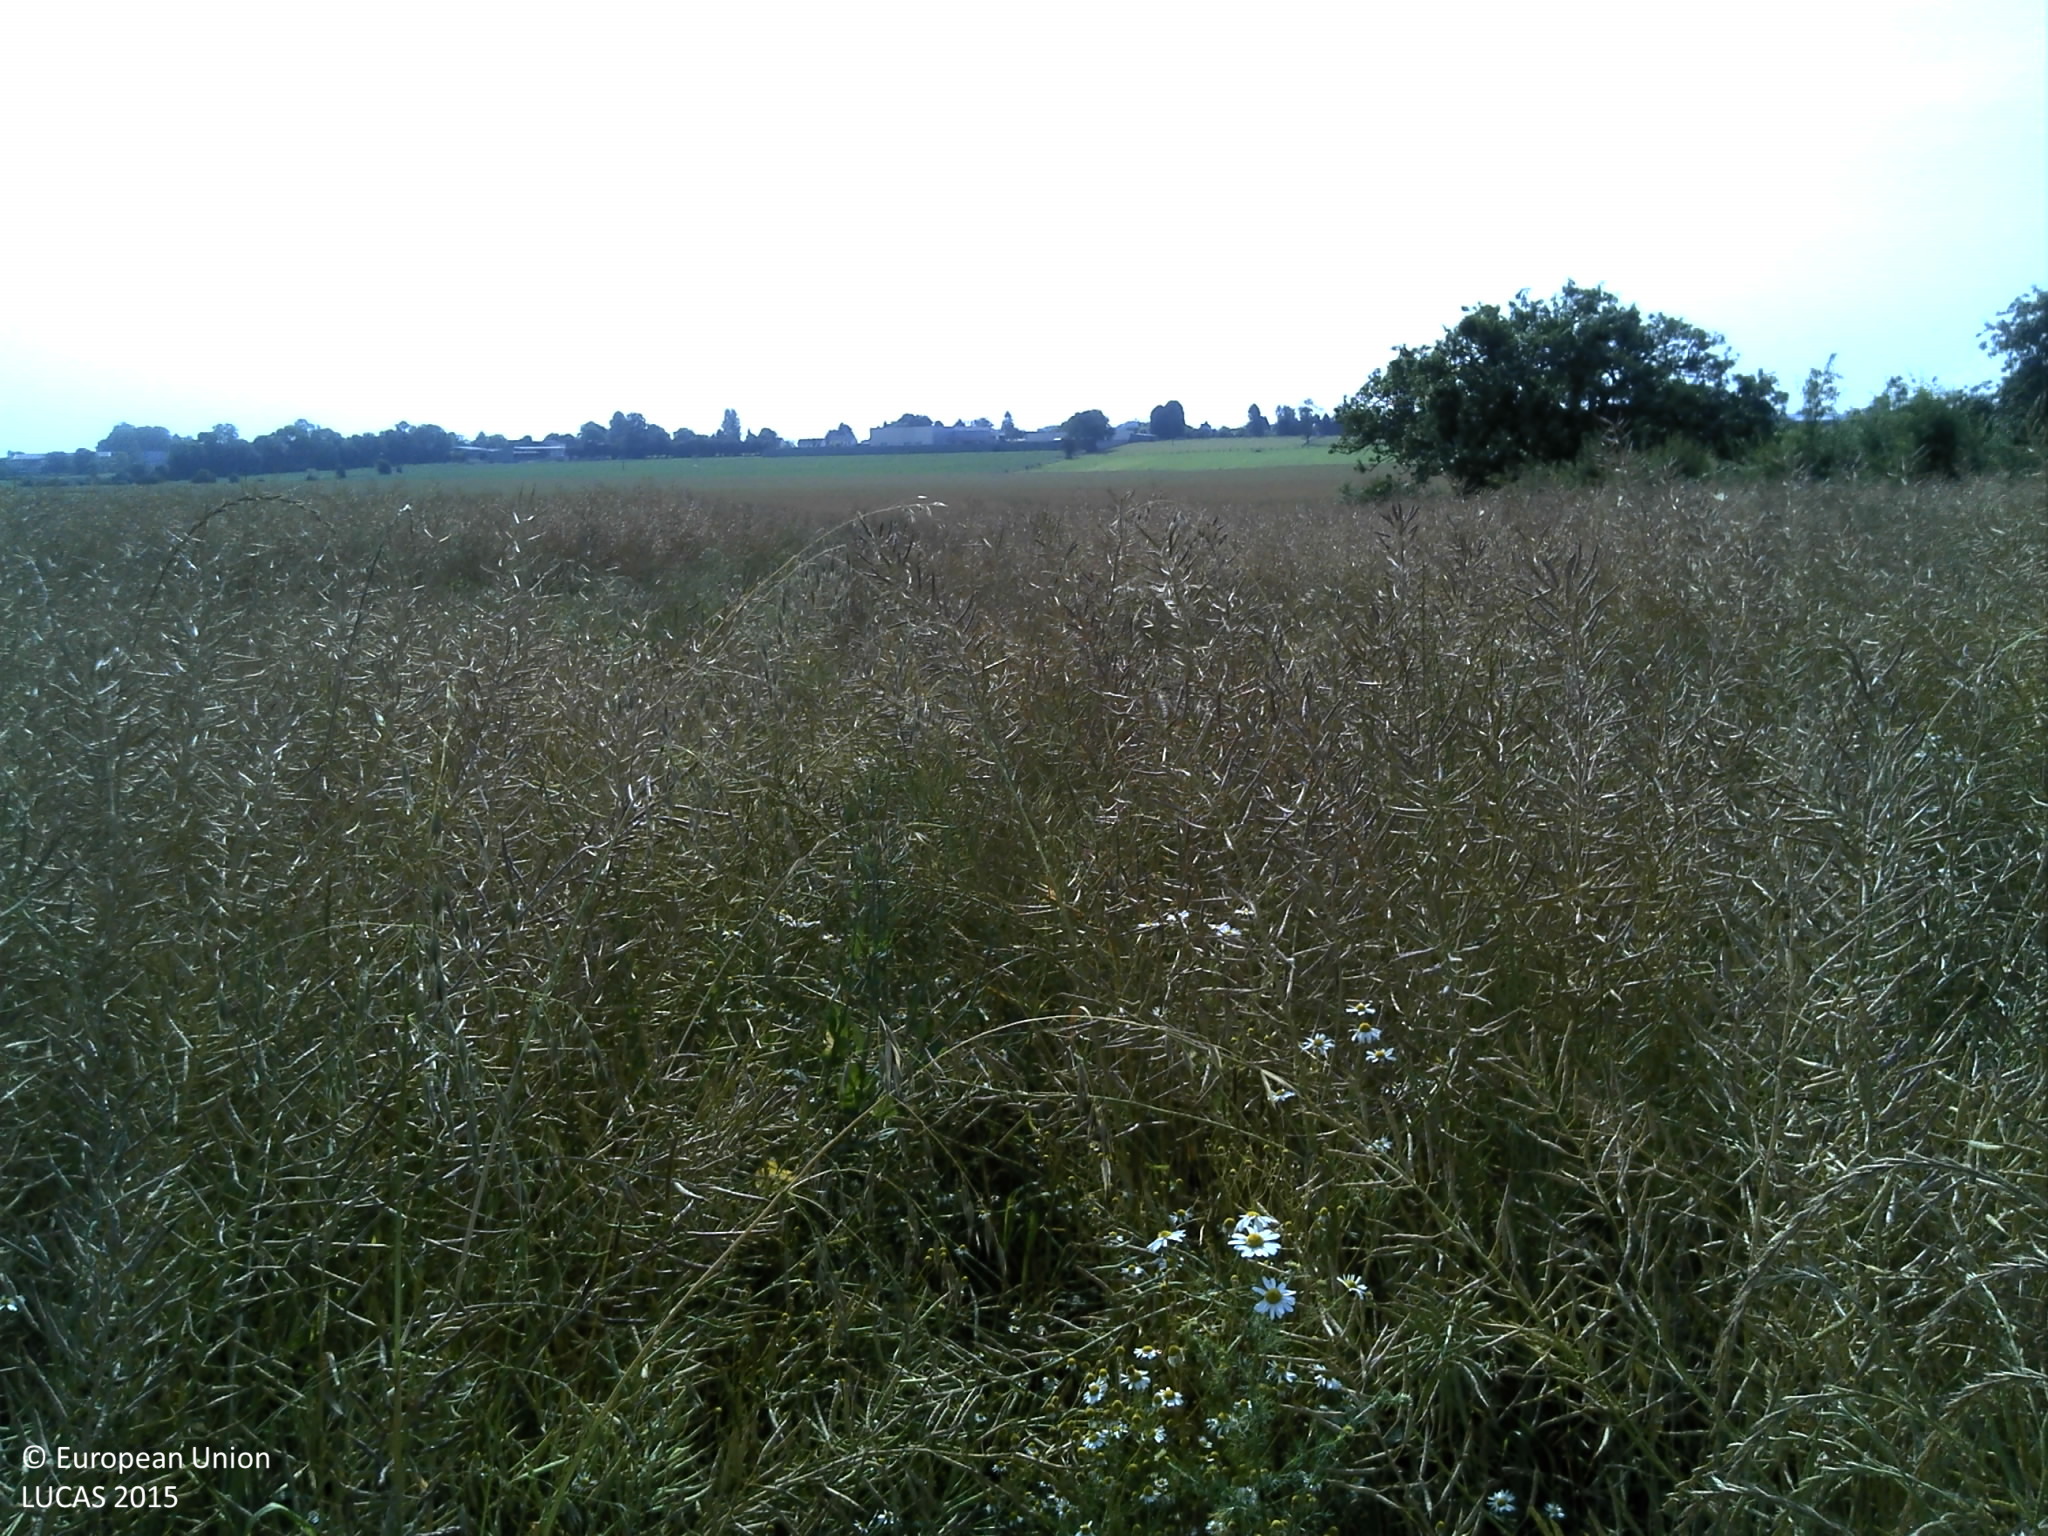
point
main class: Cropland
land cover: Rape and turnip rape
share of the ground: > 75 %
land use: Agriculture (excluding fallow land and kitchen gardens)
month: July
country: FR
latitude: 49.4828
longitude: 1.2144
